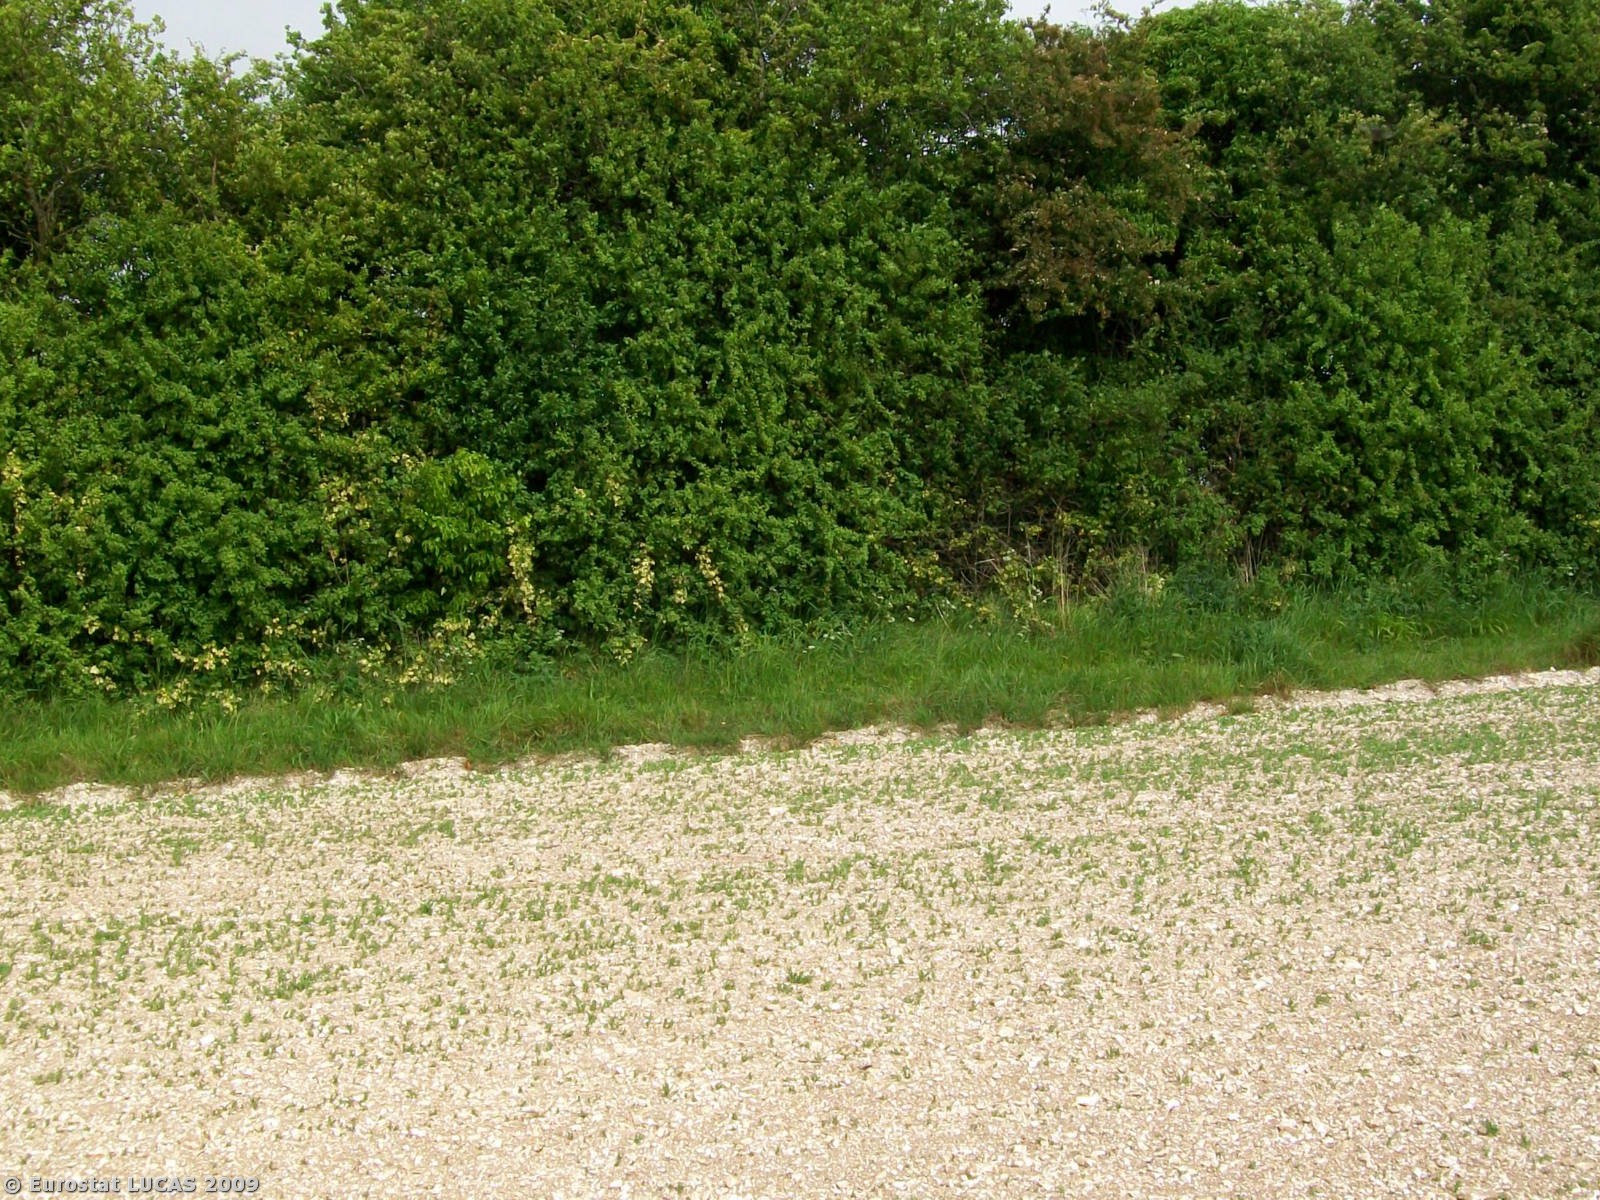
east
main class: Cropland
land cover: Other fibre and oleaginous crops
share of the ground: 25 - 50 %
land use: Agriculture (excluding fallow land and kitchen gardens)
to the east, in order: Other fibre and oleaginous crops; Grass margins; Abandoned hedges; Grass margins; Other fibre and oleaginous crops
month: May
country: GB
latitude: 50.8976
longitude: -2.1317
